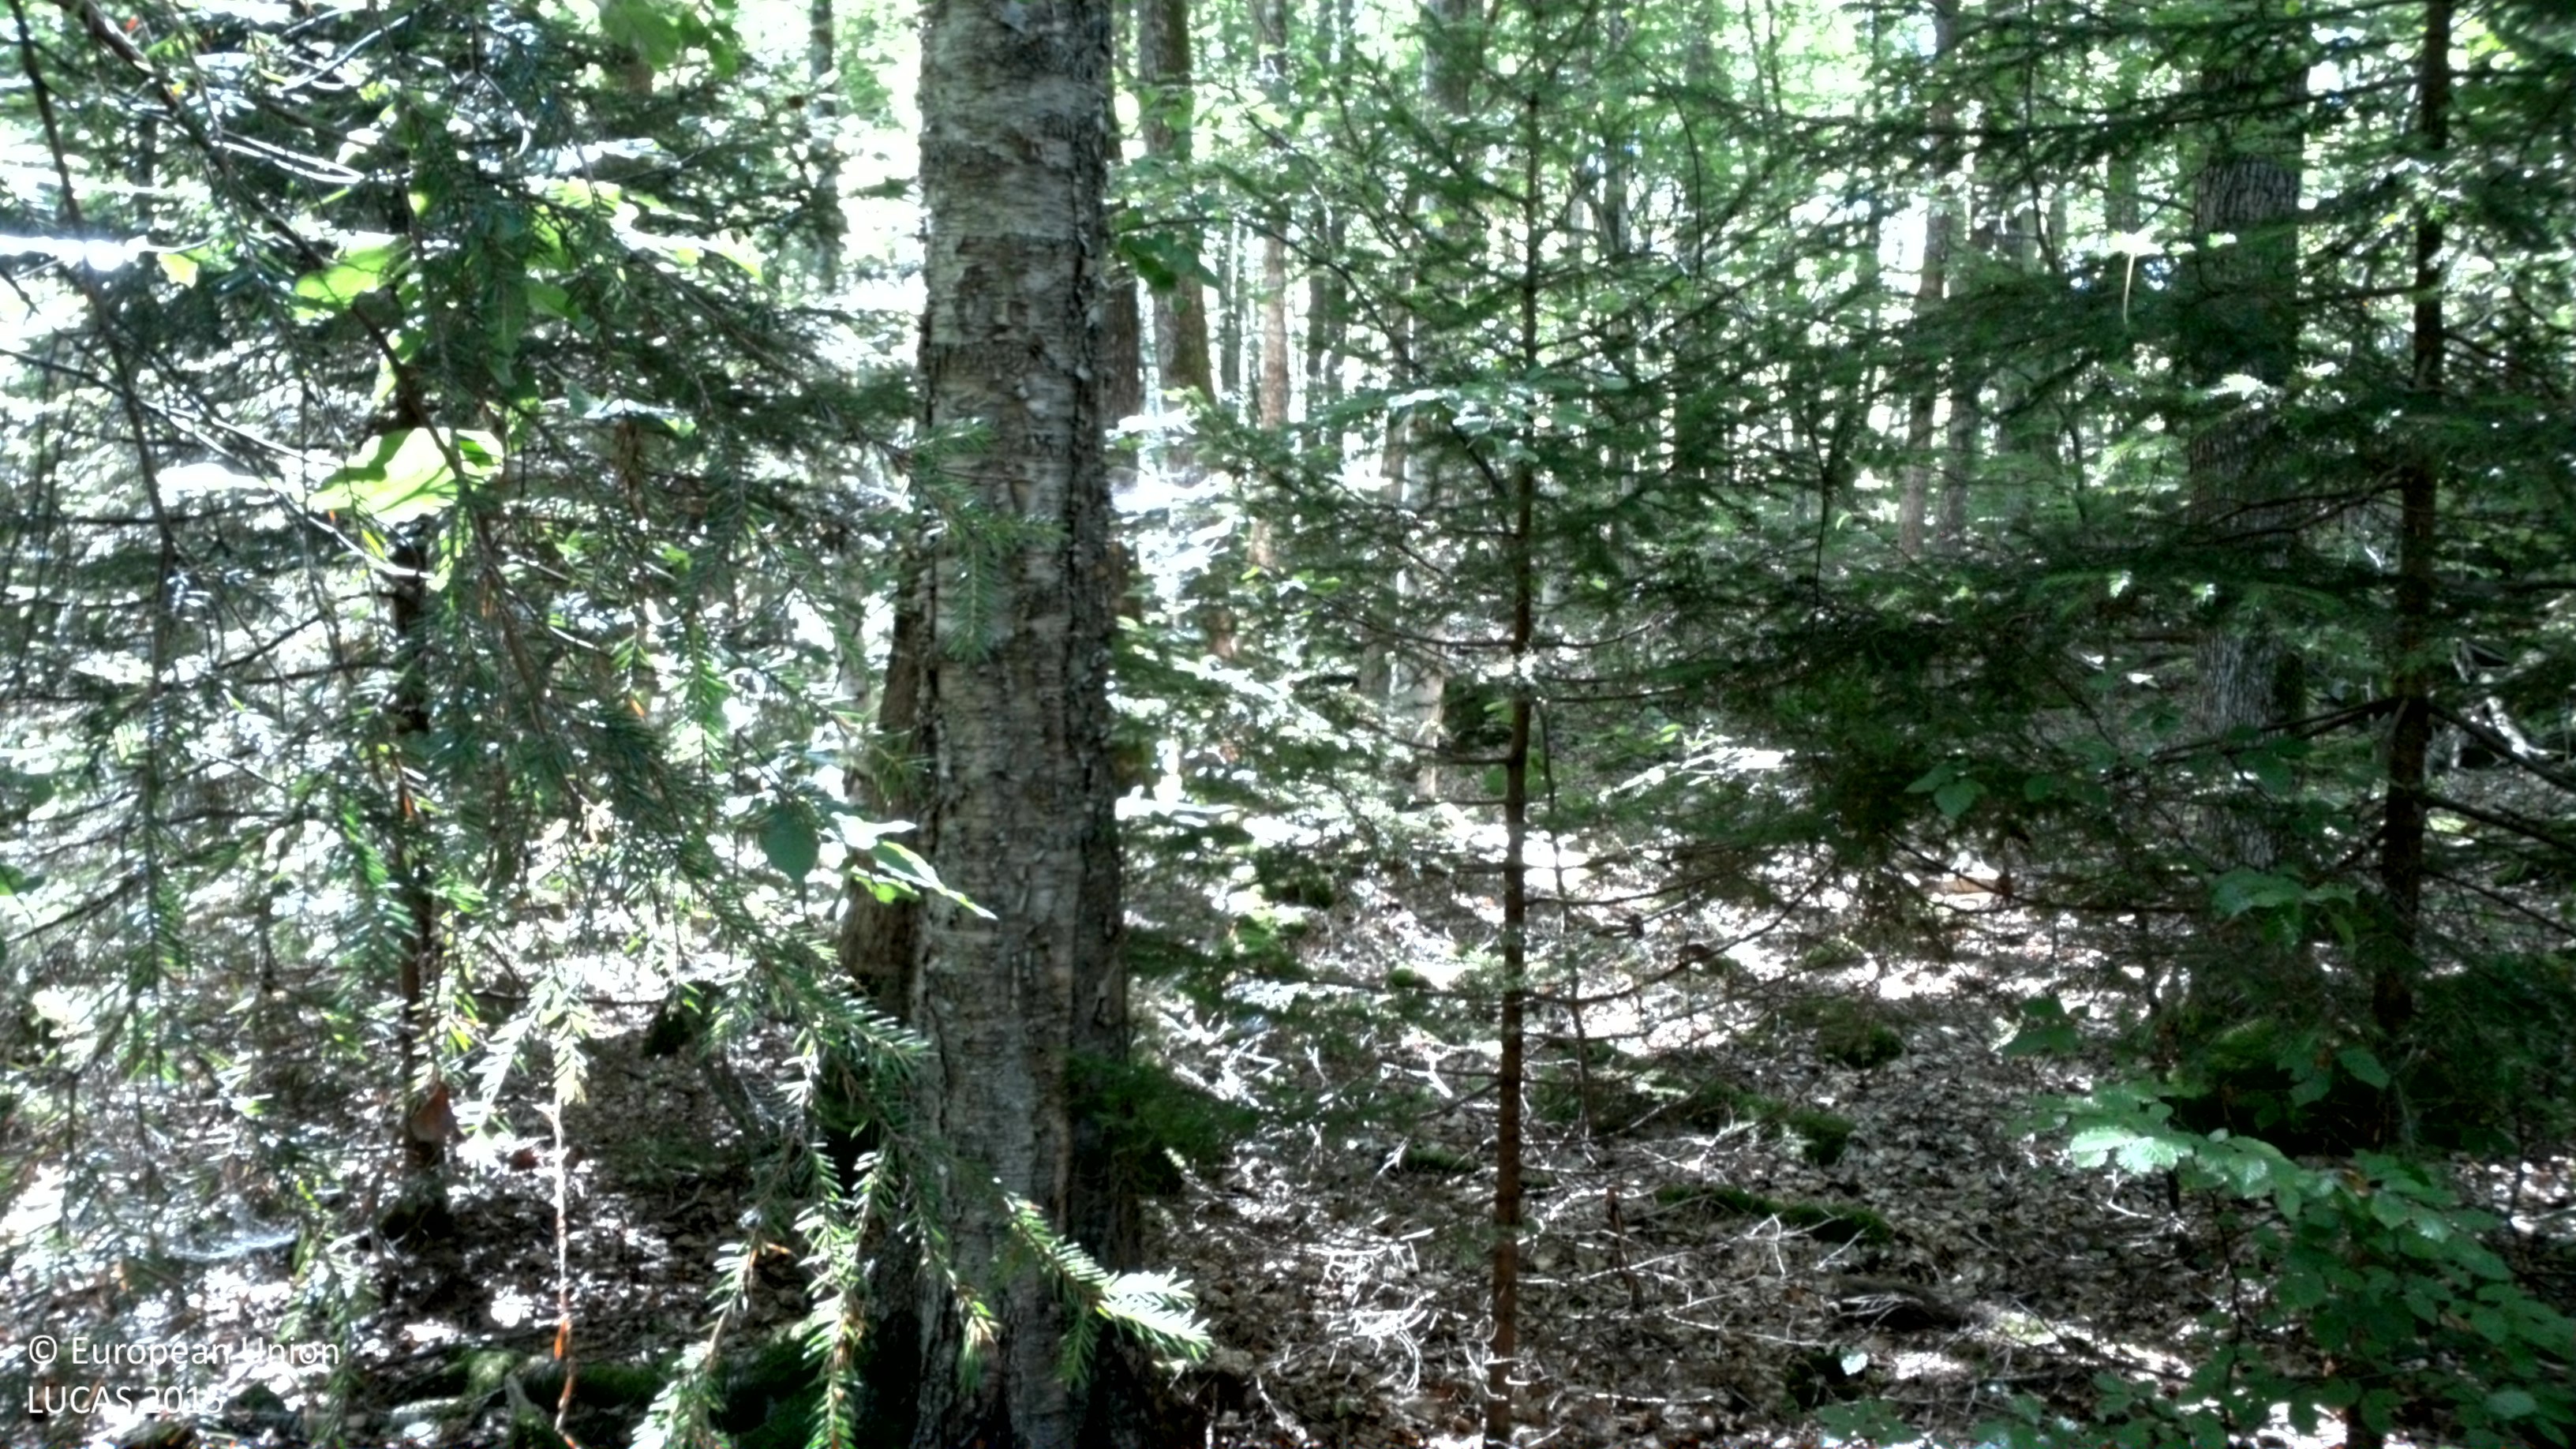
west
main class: Woodland
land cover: Broadleaved woodland
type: beech forest
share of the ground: > 75 %
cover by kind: broadleaved forest trees 75 %, coniferous forest trees 5 %, herbaceous plants 5 %
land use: Forestry
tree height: > 5 m
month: August
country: SE
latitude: 56.2640
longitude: 14.6963
